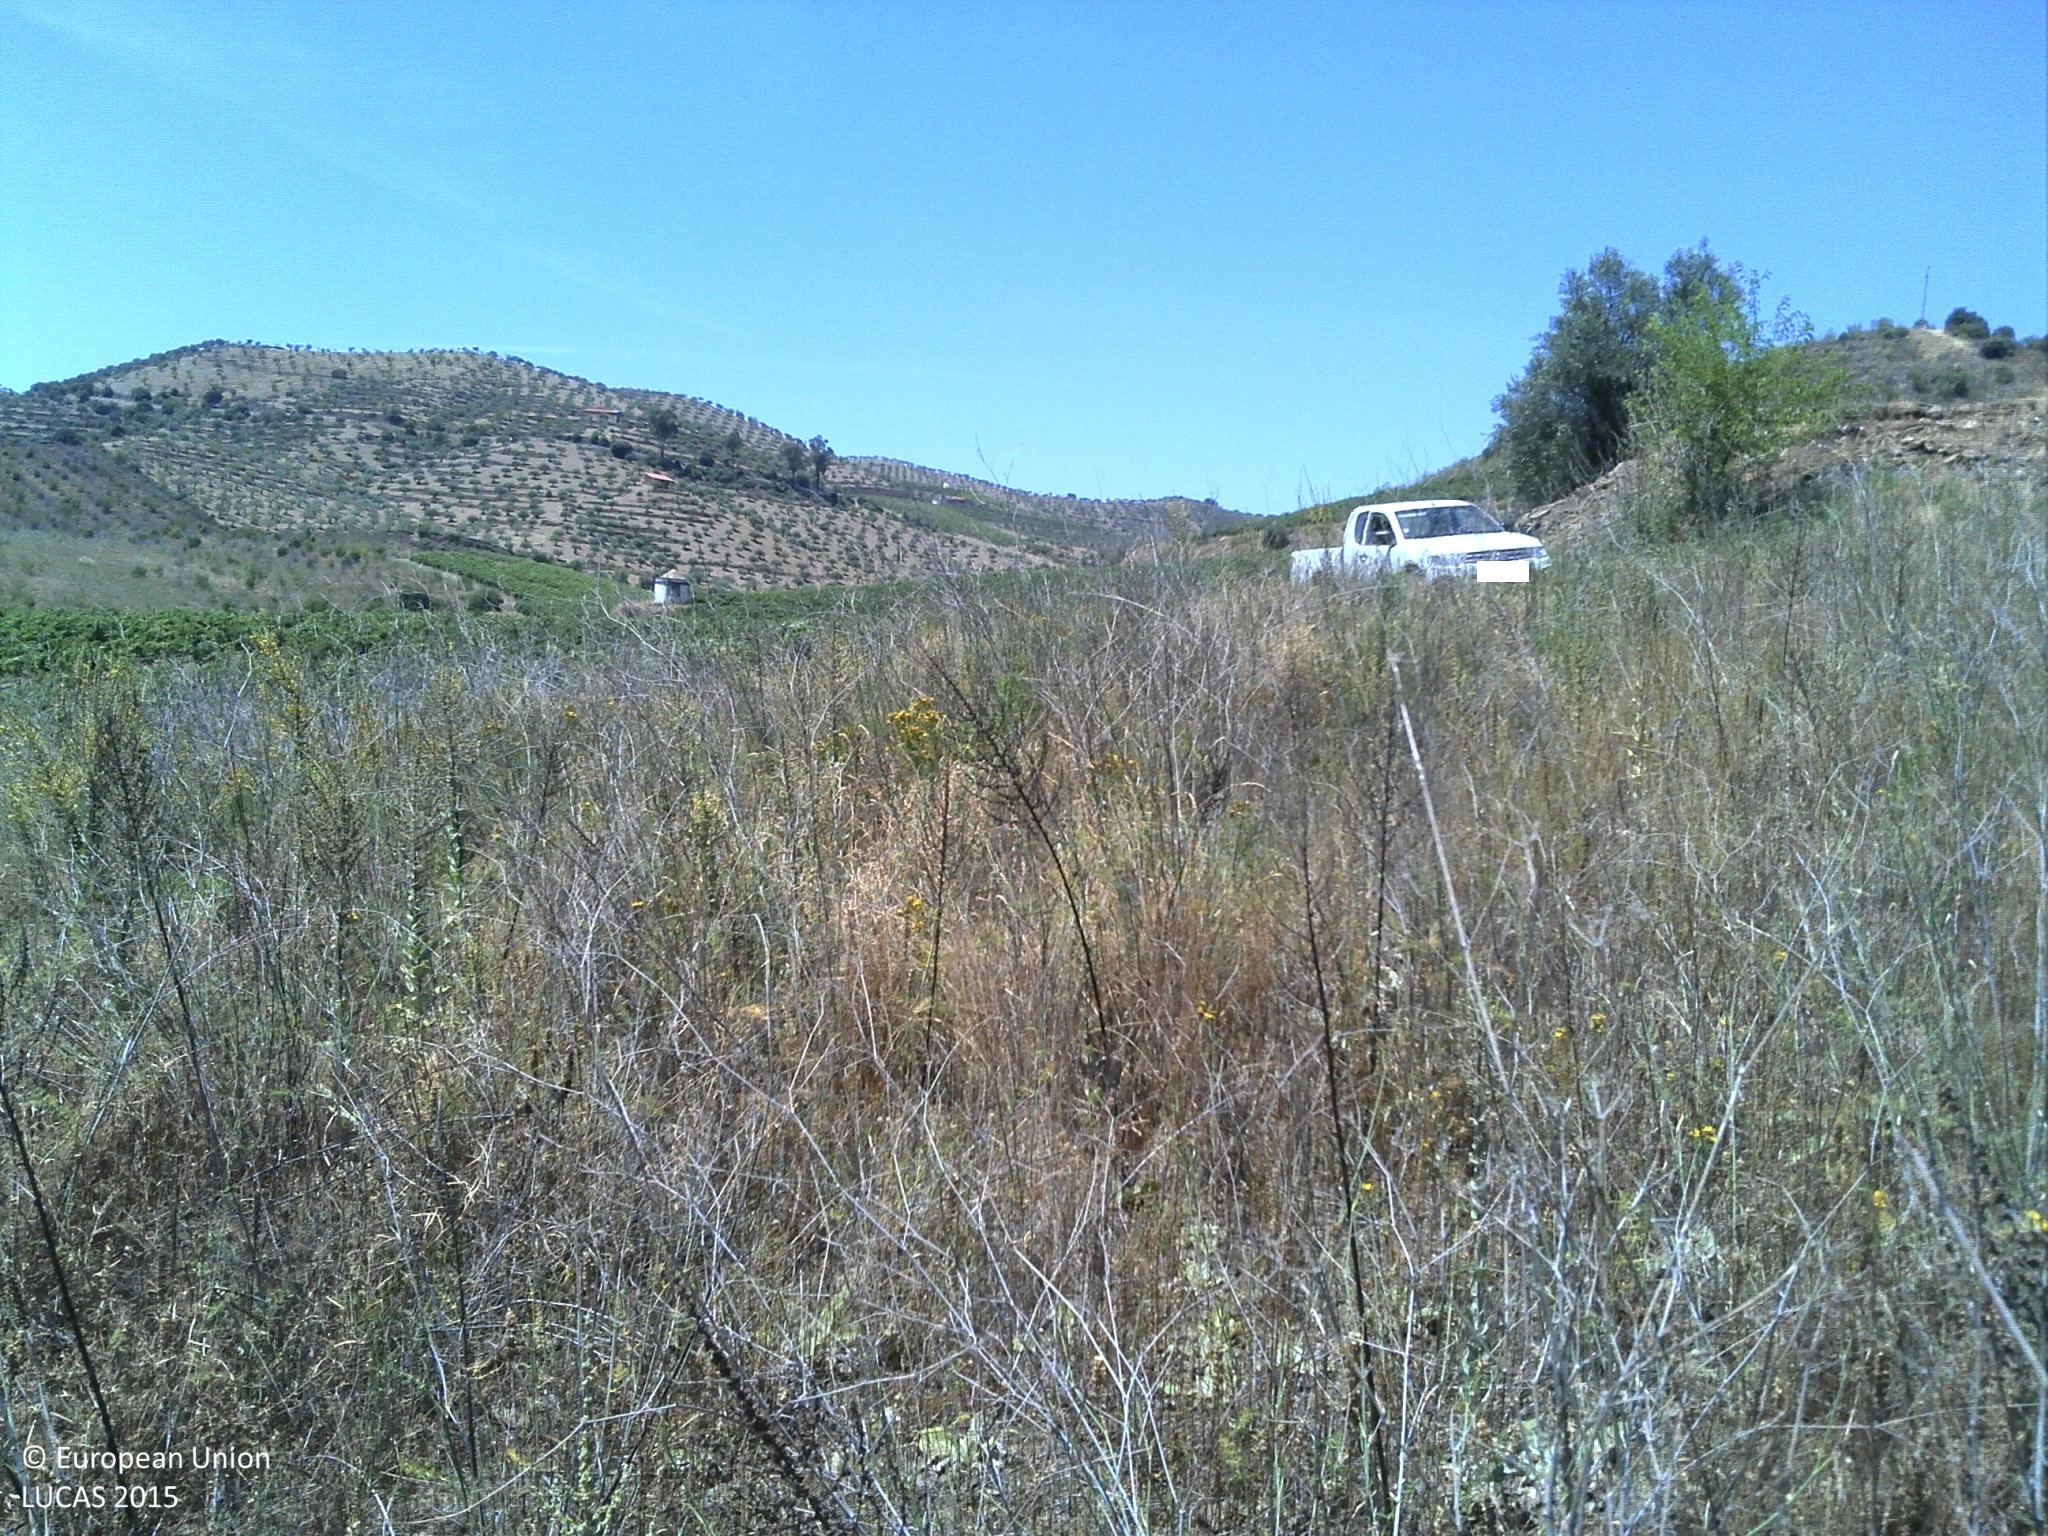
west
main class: Grassland
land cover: Spontaneously vegetated surfaces
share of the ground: > 75 %
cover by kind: herbaceous plants 95 %, unconsolidated bare surface 5 %
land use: Fallow land
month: June
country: PT
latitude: 41.0138
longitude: -6.9311
